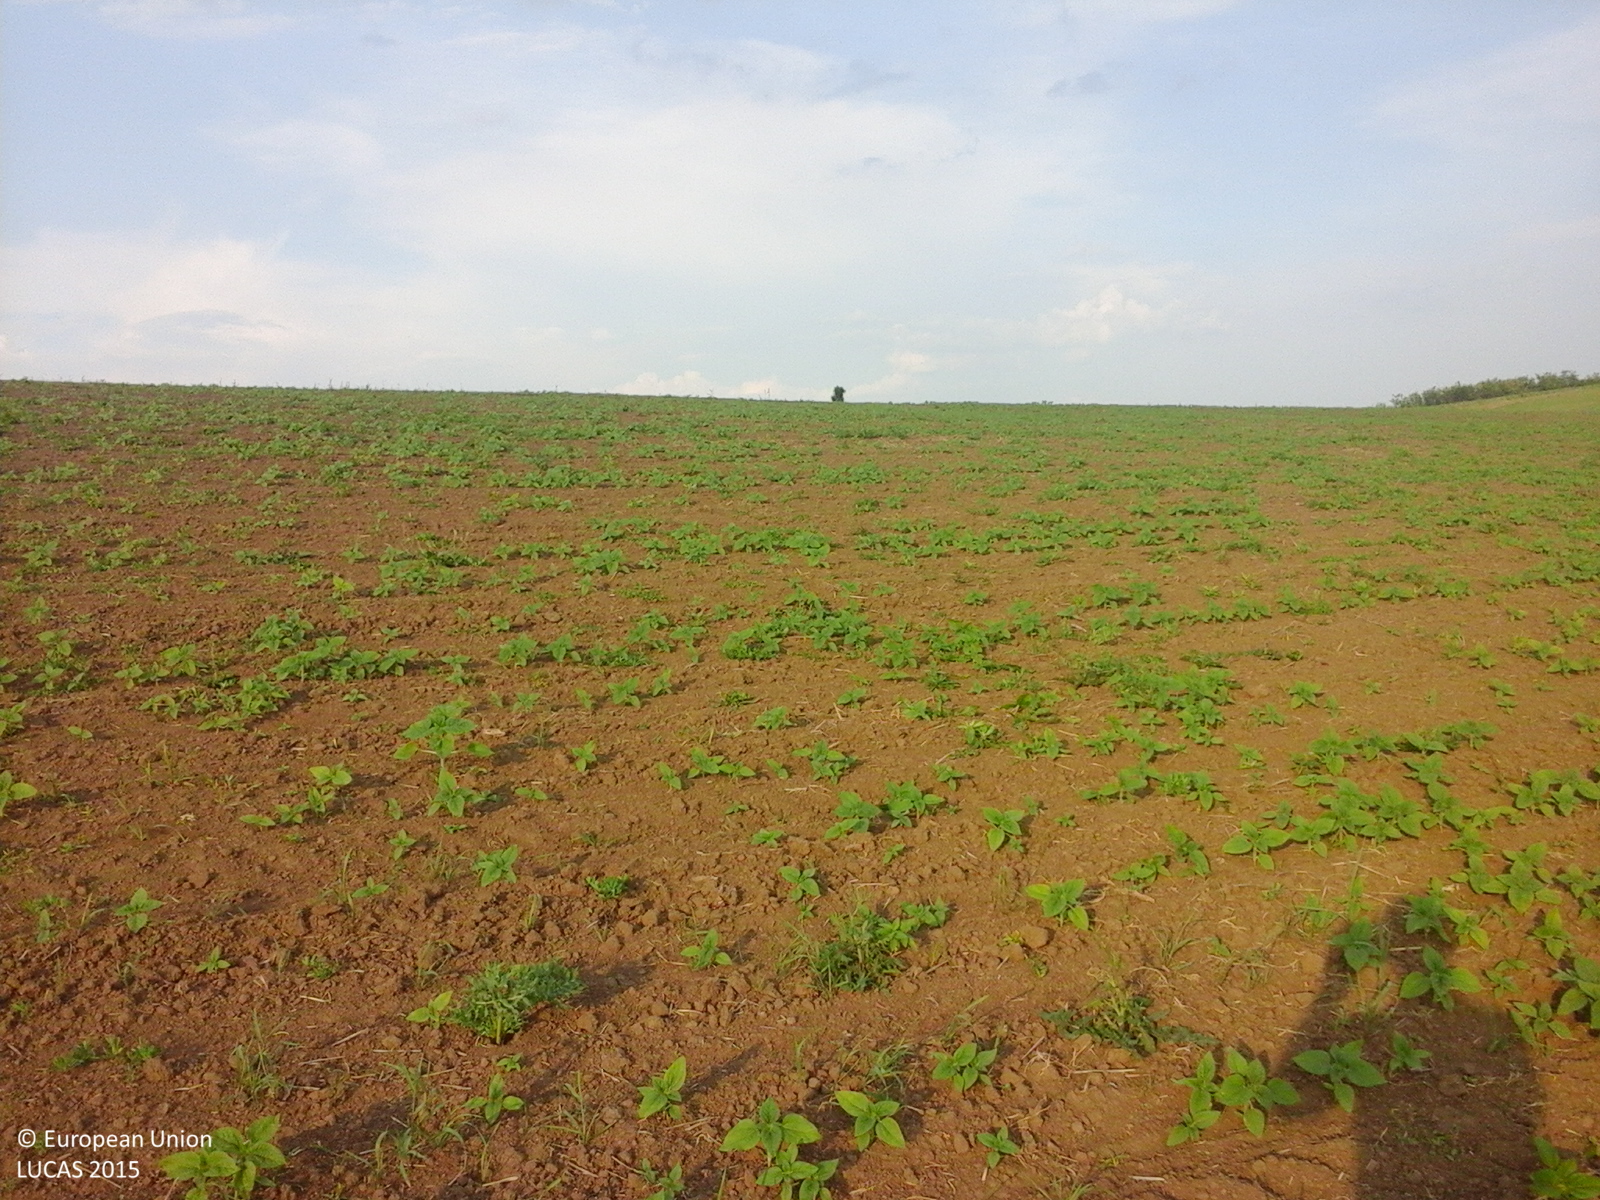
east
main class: Cropland
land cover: Sunflower
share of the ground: 10 - 25 %
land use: Agriculture (excluding fallow land and kitchen gardens)
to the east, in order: Sunflower; Grass margins; Tracks; Grass margins; Abandoned hedges; Sunflower
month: June
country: RO
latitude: 46.3234
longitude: 27.2061
